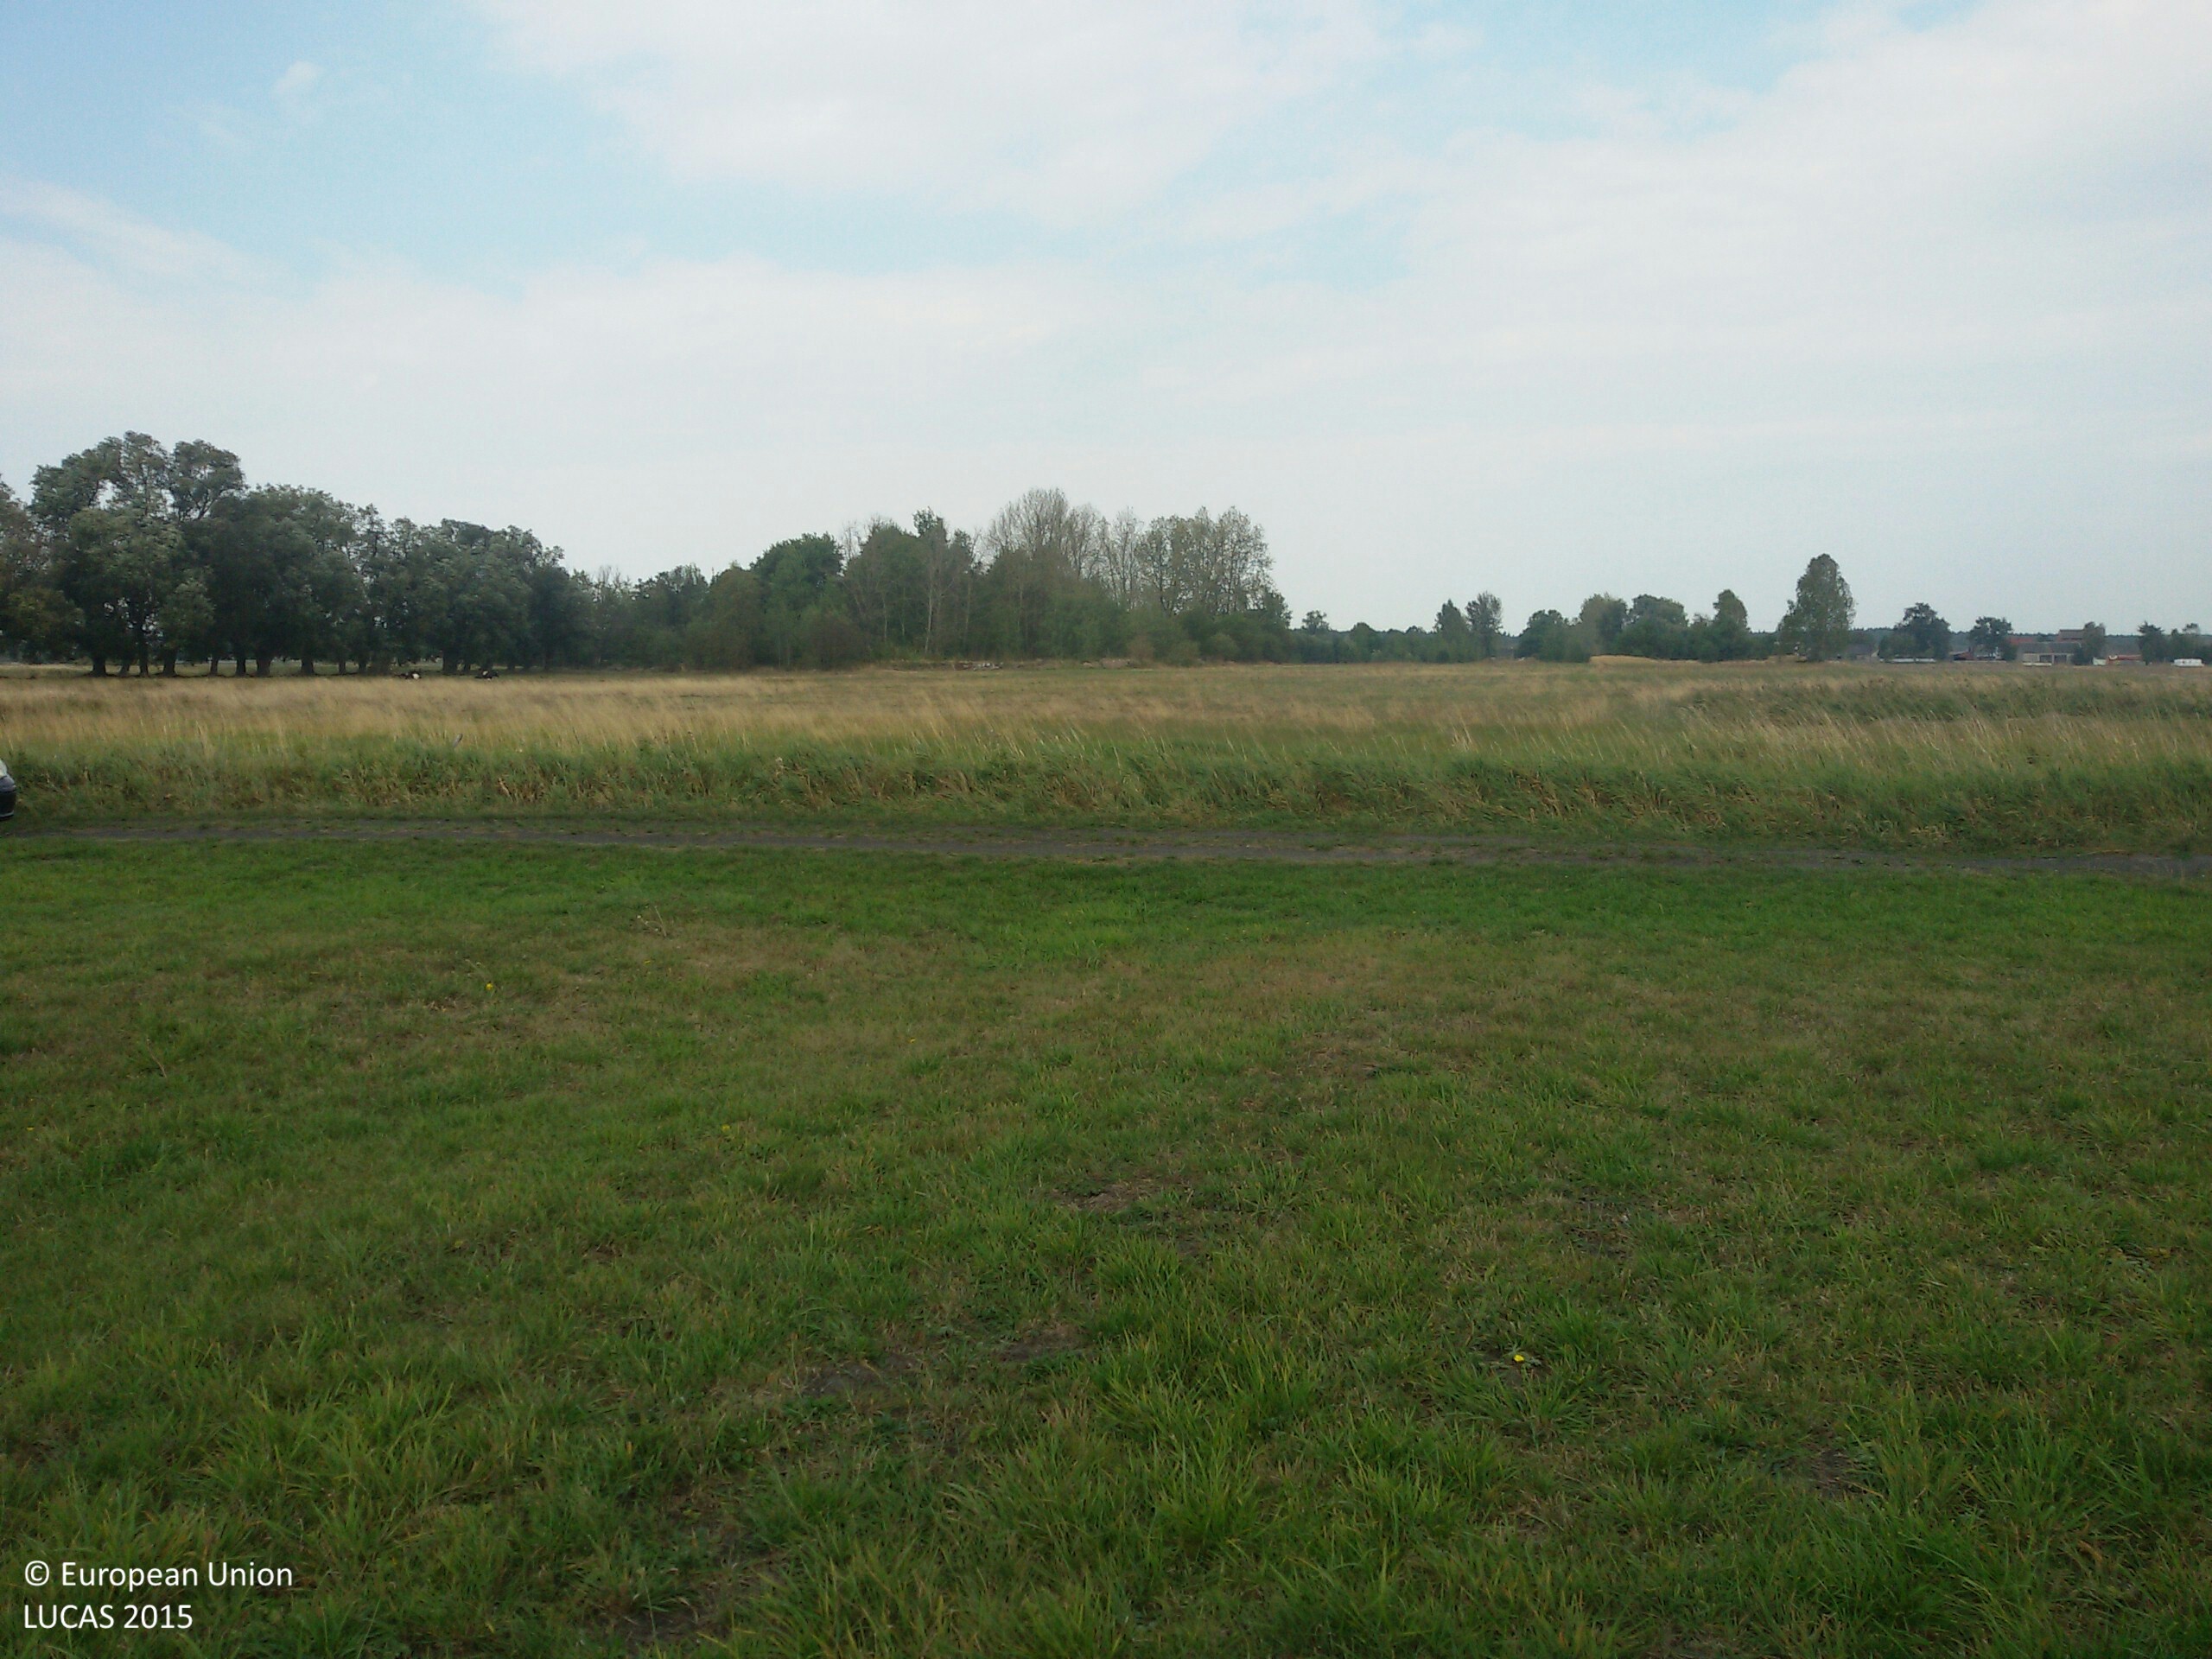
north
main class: Grassland
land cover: Grassland without tree/shrub cover
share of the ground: > 75 %
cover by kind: herbaceous plants 100 %
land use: Agriculture (excluding fallow land and kitchen gardens)
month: September
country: PL
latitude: 50.7921
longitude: 19.6044
